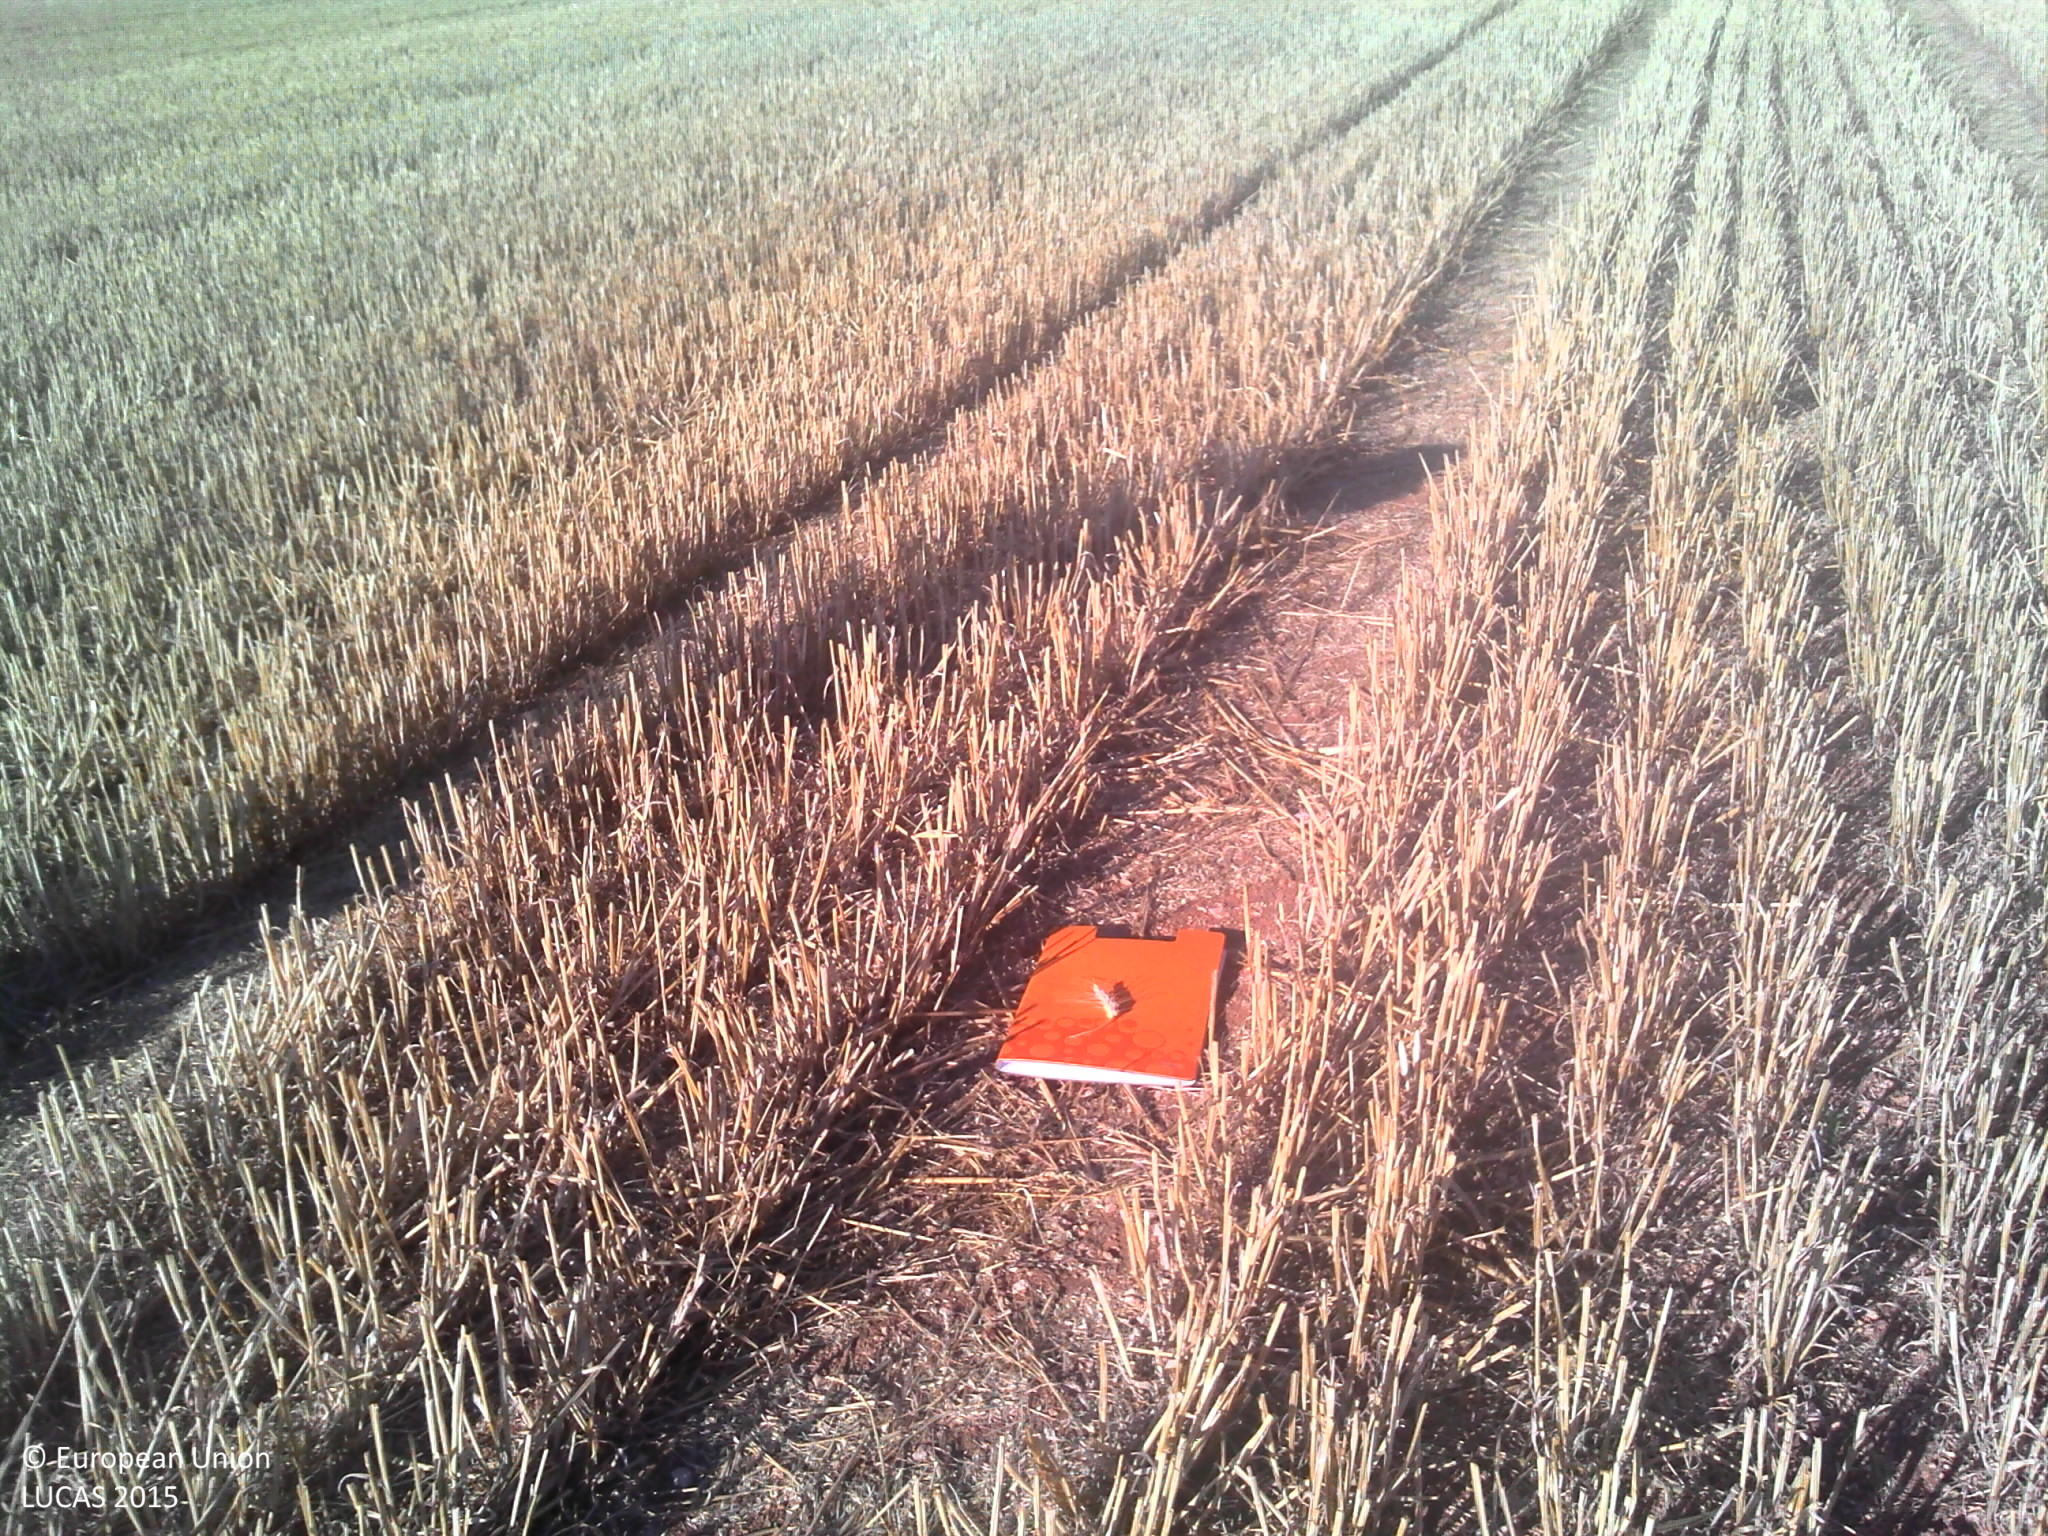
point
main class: Cropland
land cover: Common wheat
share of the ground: 10 - 25 %
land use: Agriculture (excluding fallow land and kitchen gardens)
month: August
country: FR
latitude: 47.7841
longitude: 4.9676
